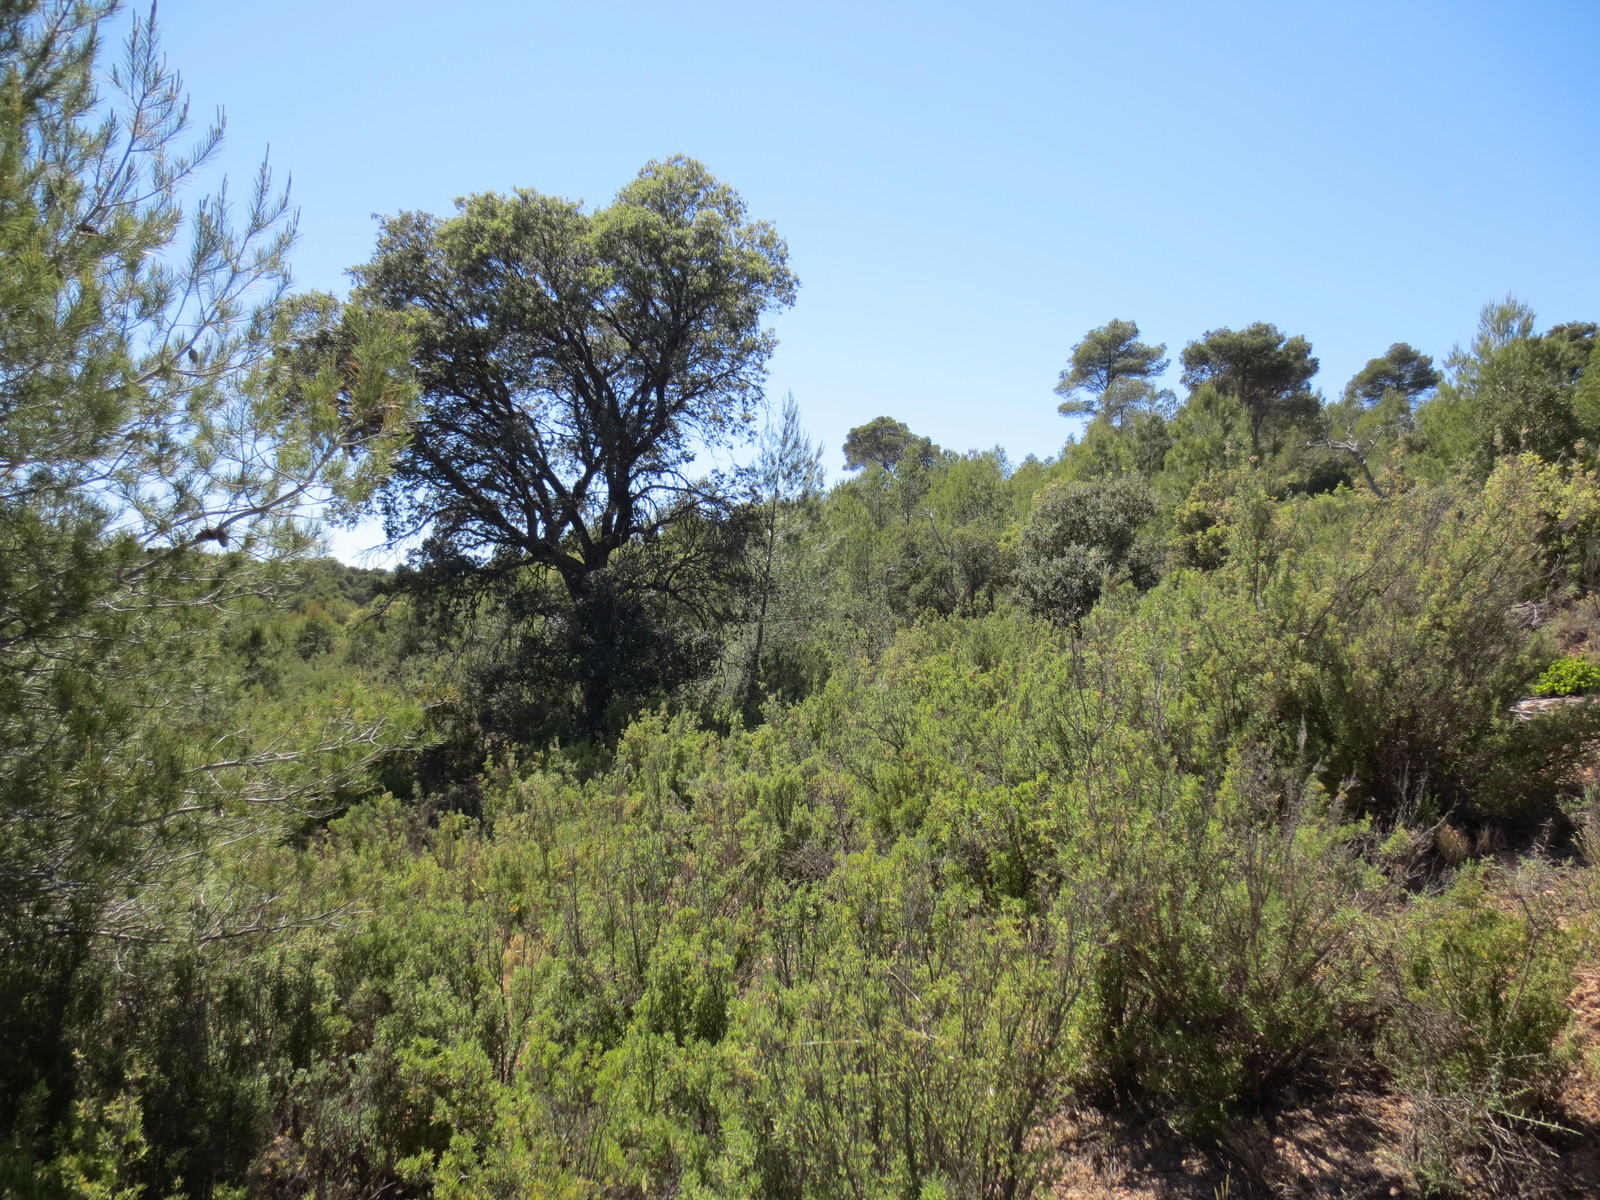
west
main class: Shrubland
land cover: Shrubland with sparse tree cover
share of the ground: > 75 %
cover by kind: shrubs 75 %, unconsolidated bare surface 20 %, coniferous forest trees 5 %
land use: Semi-natural and natural areas not in use
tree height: < 5 m
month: May
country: ES
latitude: 40.2240
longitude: -2.8458
